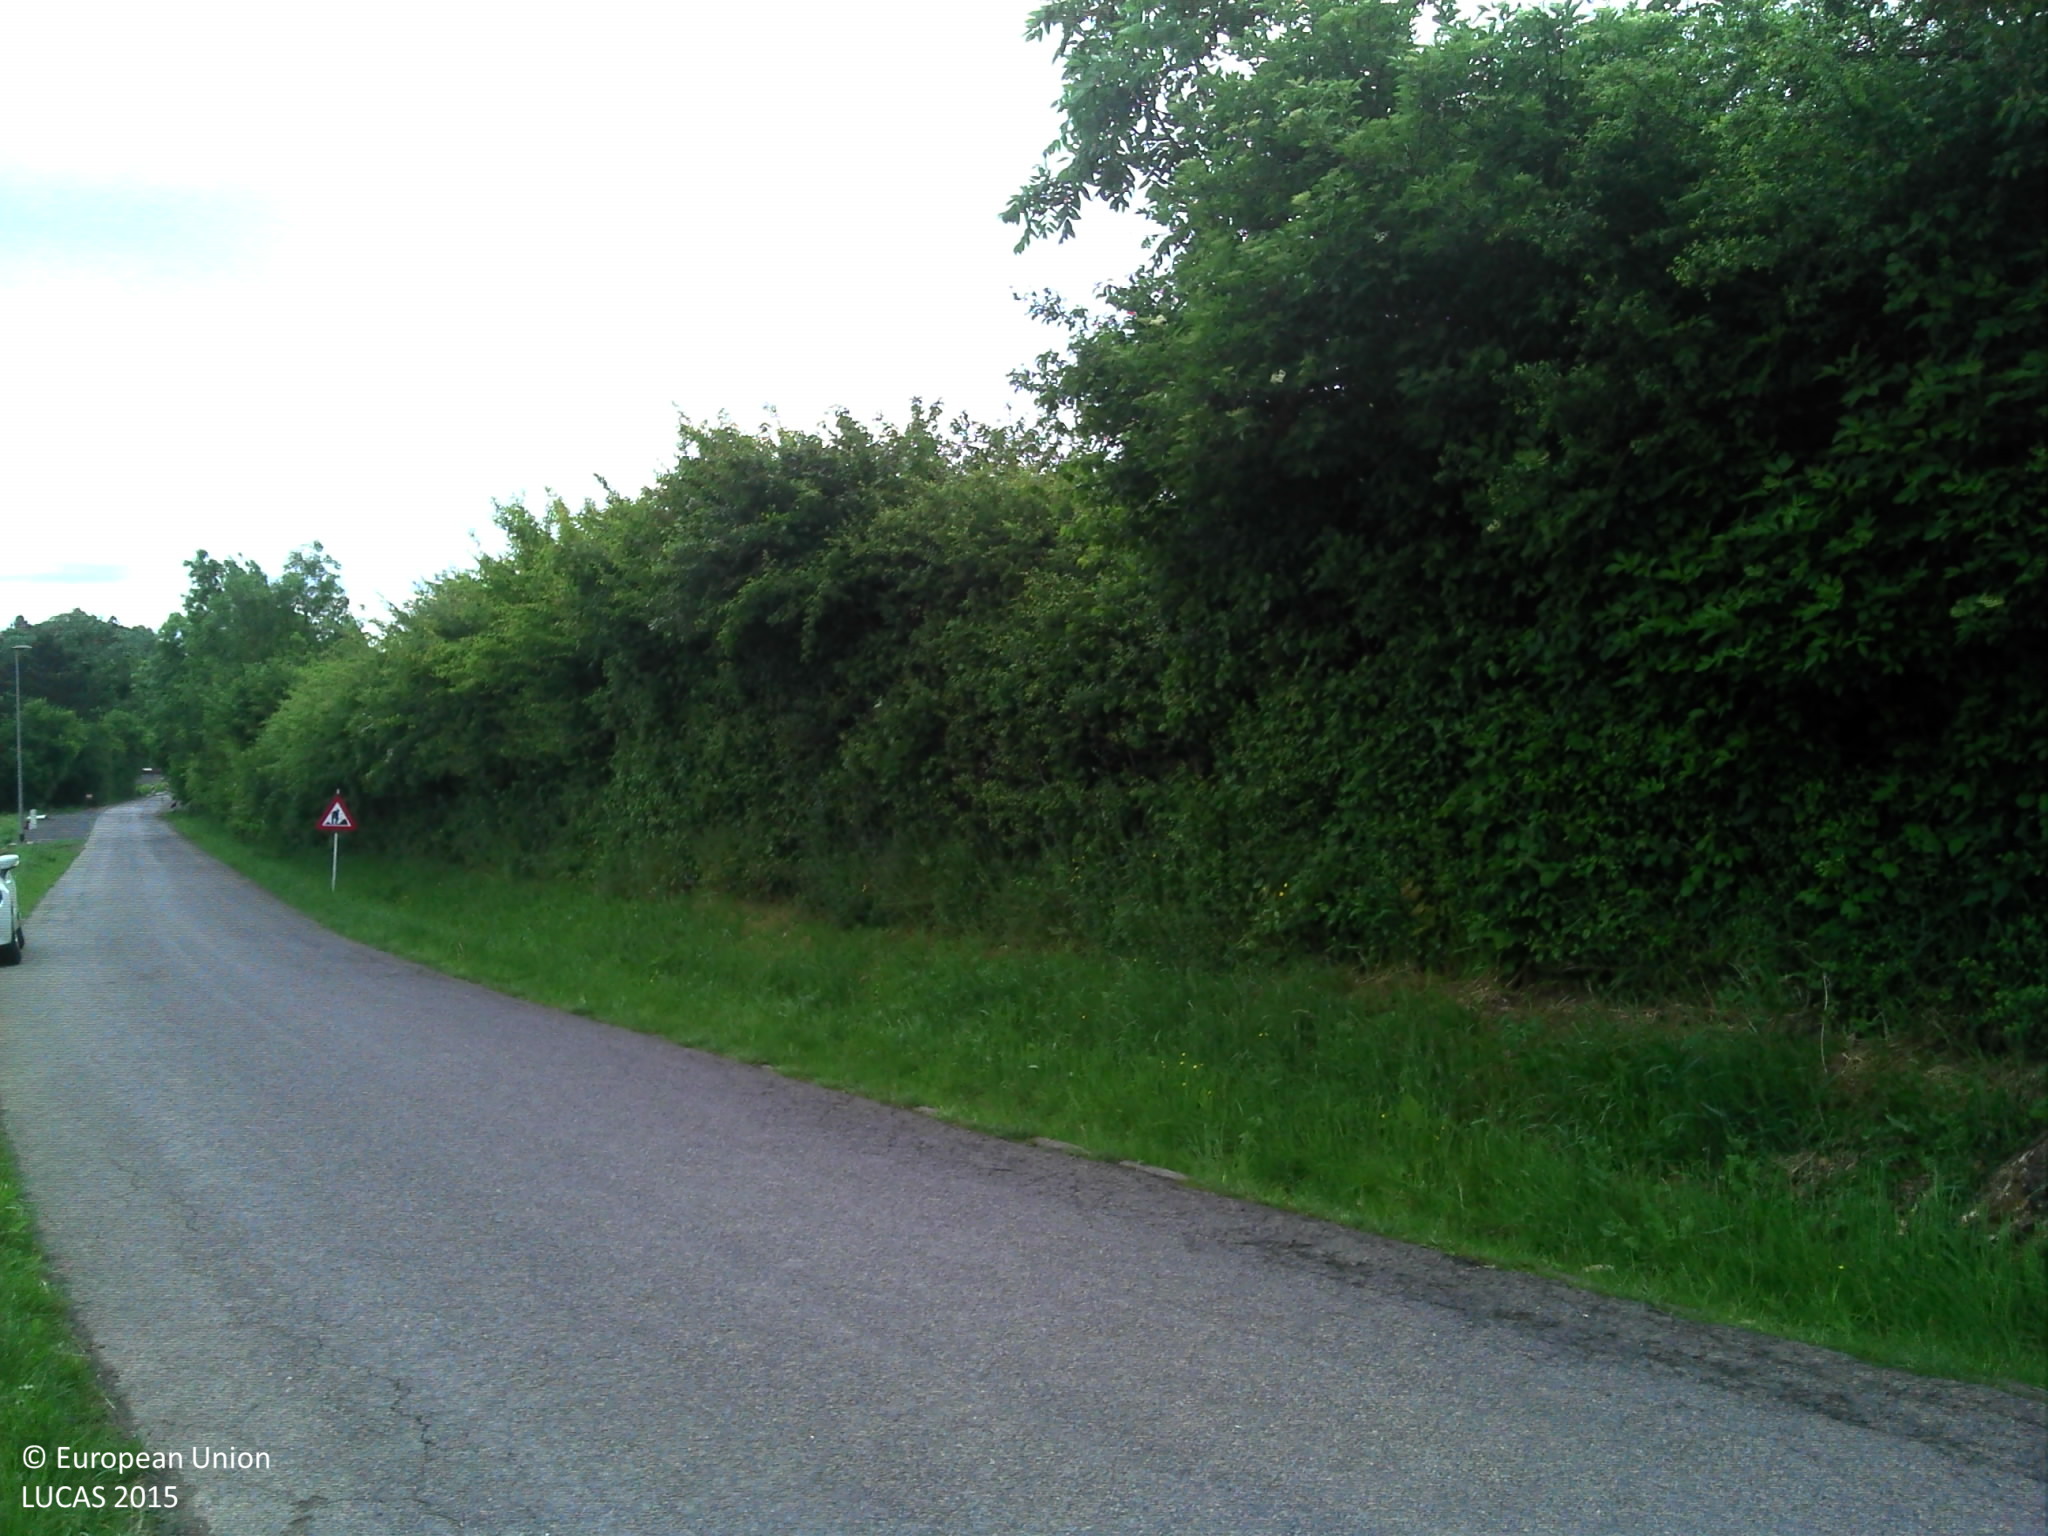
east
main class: Cropland
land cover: Rape and turnip rape
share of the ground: > 75 %
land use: Agriculture (excluding fallow land and kitchen gardens)
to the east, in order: Rape and turnip rape; Abandoned hedges; Paved roads, cycling and walking lanes; Grass margins; Abandoned hedges; Other bare soil; Grassland without tree/shrub cover; Artificial constructions in urban areas; Grassland without tree/shrub cover
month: June
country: BE
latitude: 50.4412
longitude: 5.5911
